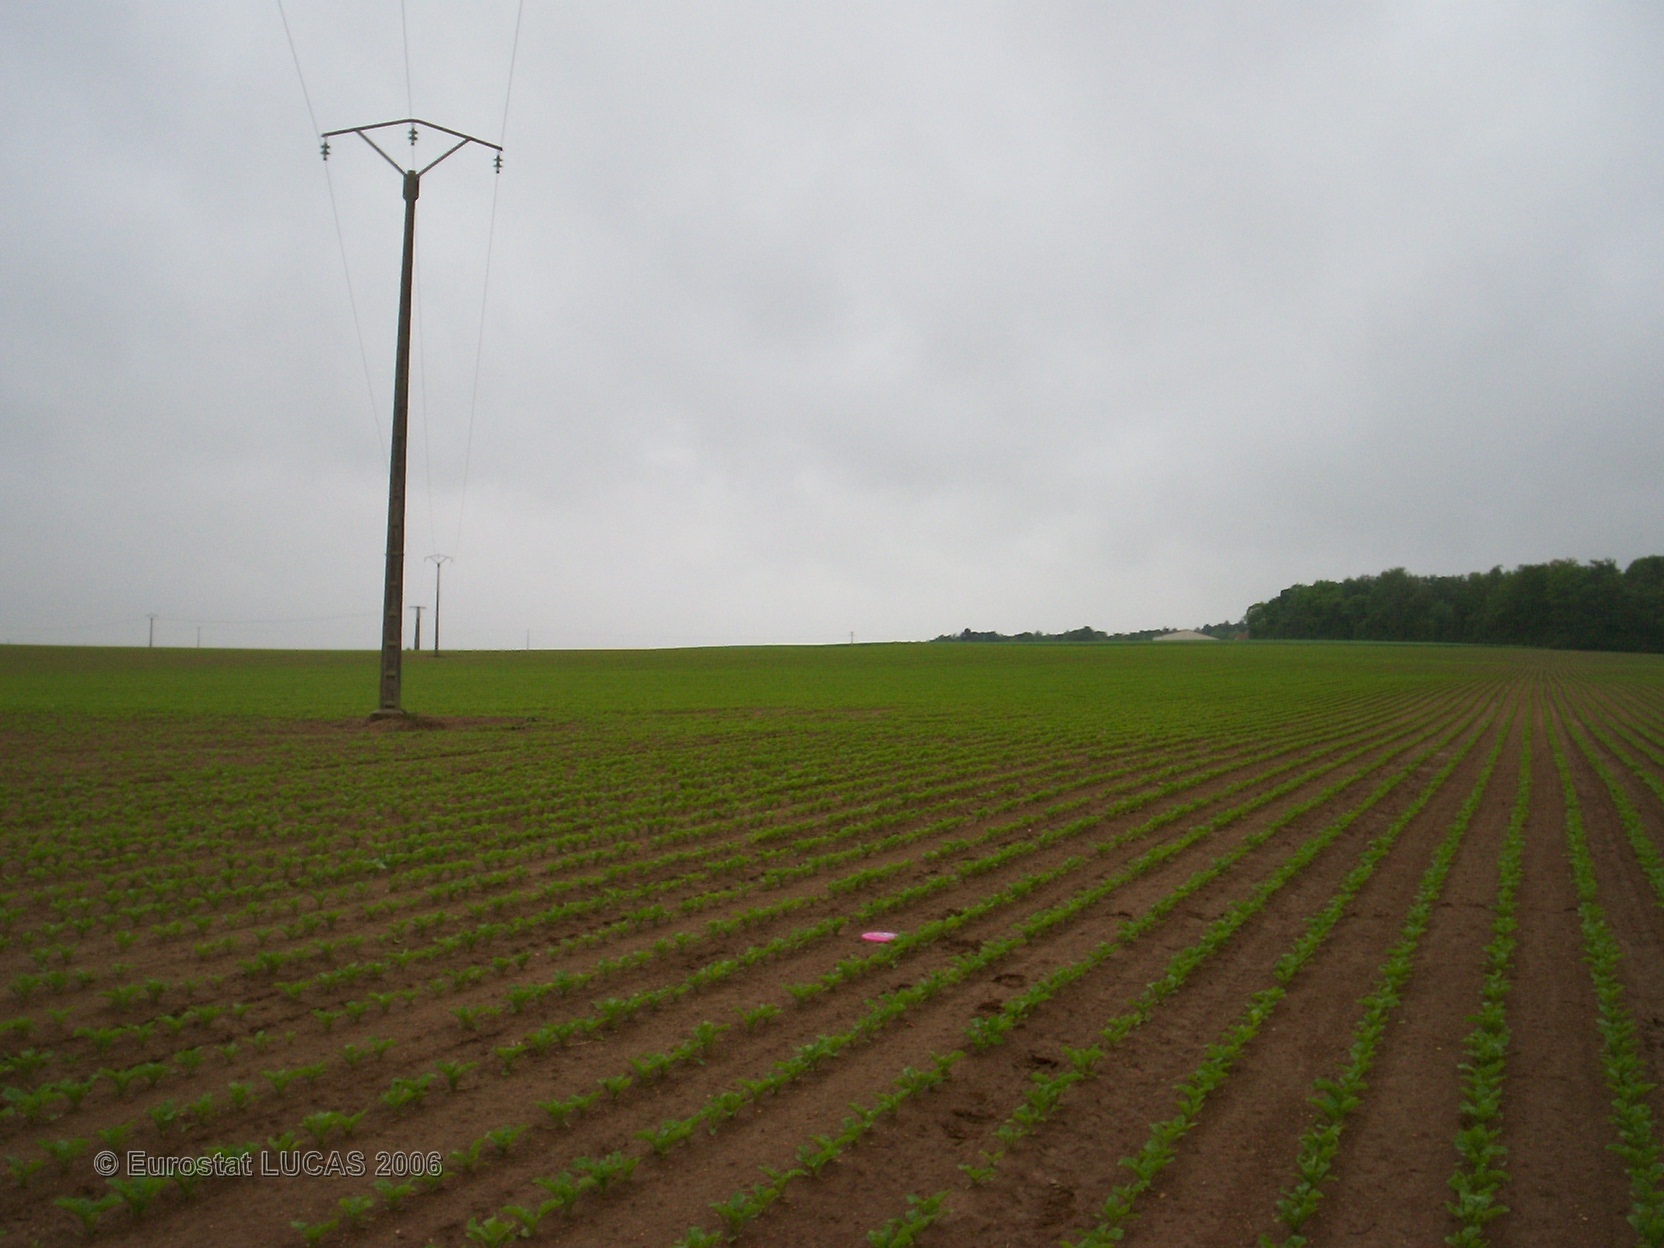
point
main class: Cropland
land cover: Sugar beet
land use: Agriculture (excluding fallow land and kitchen gardens)
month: May
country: FR
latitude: 49.4150
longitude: 4.3859
